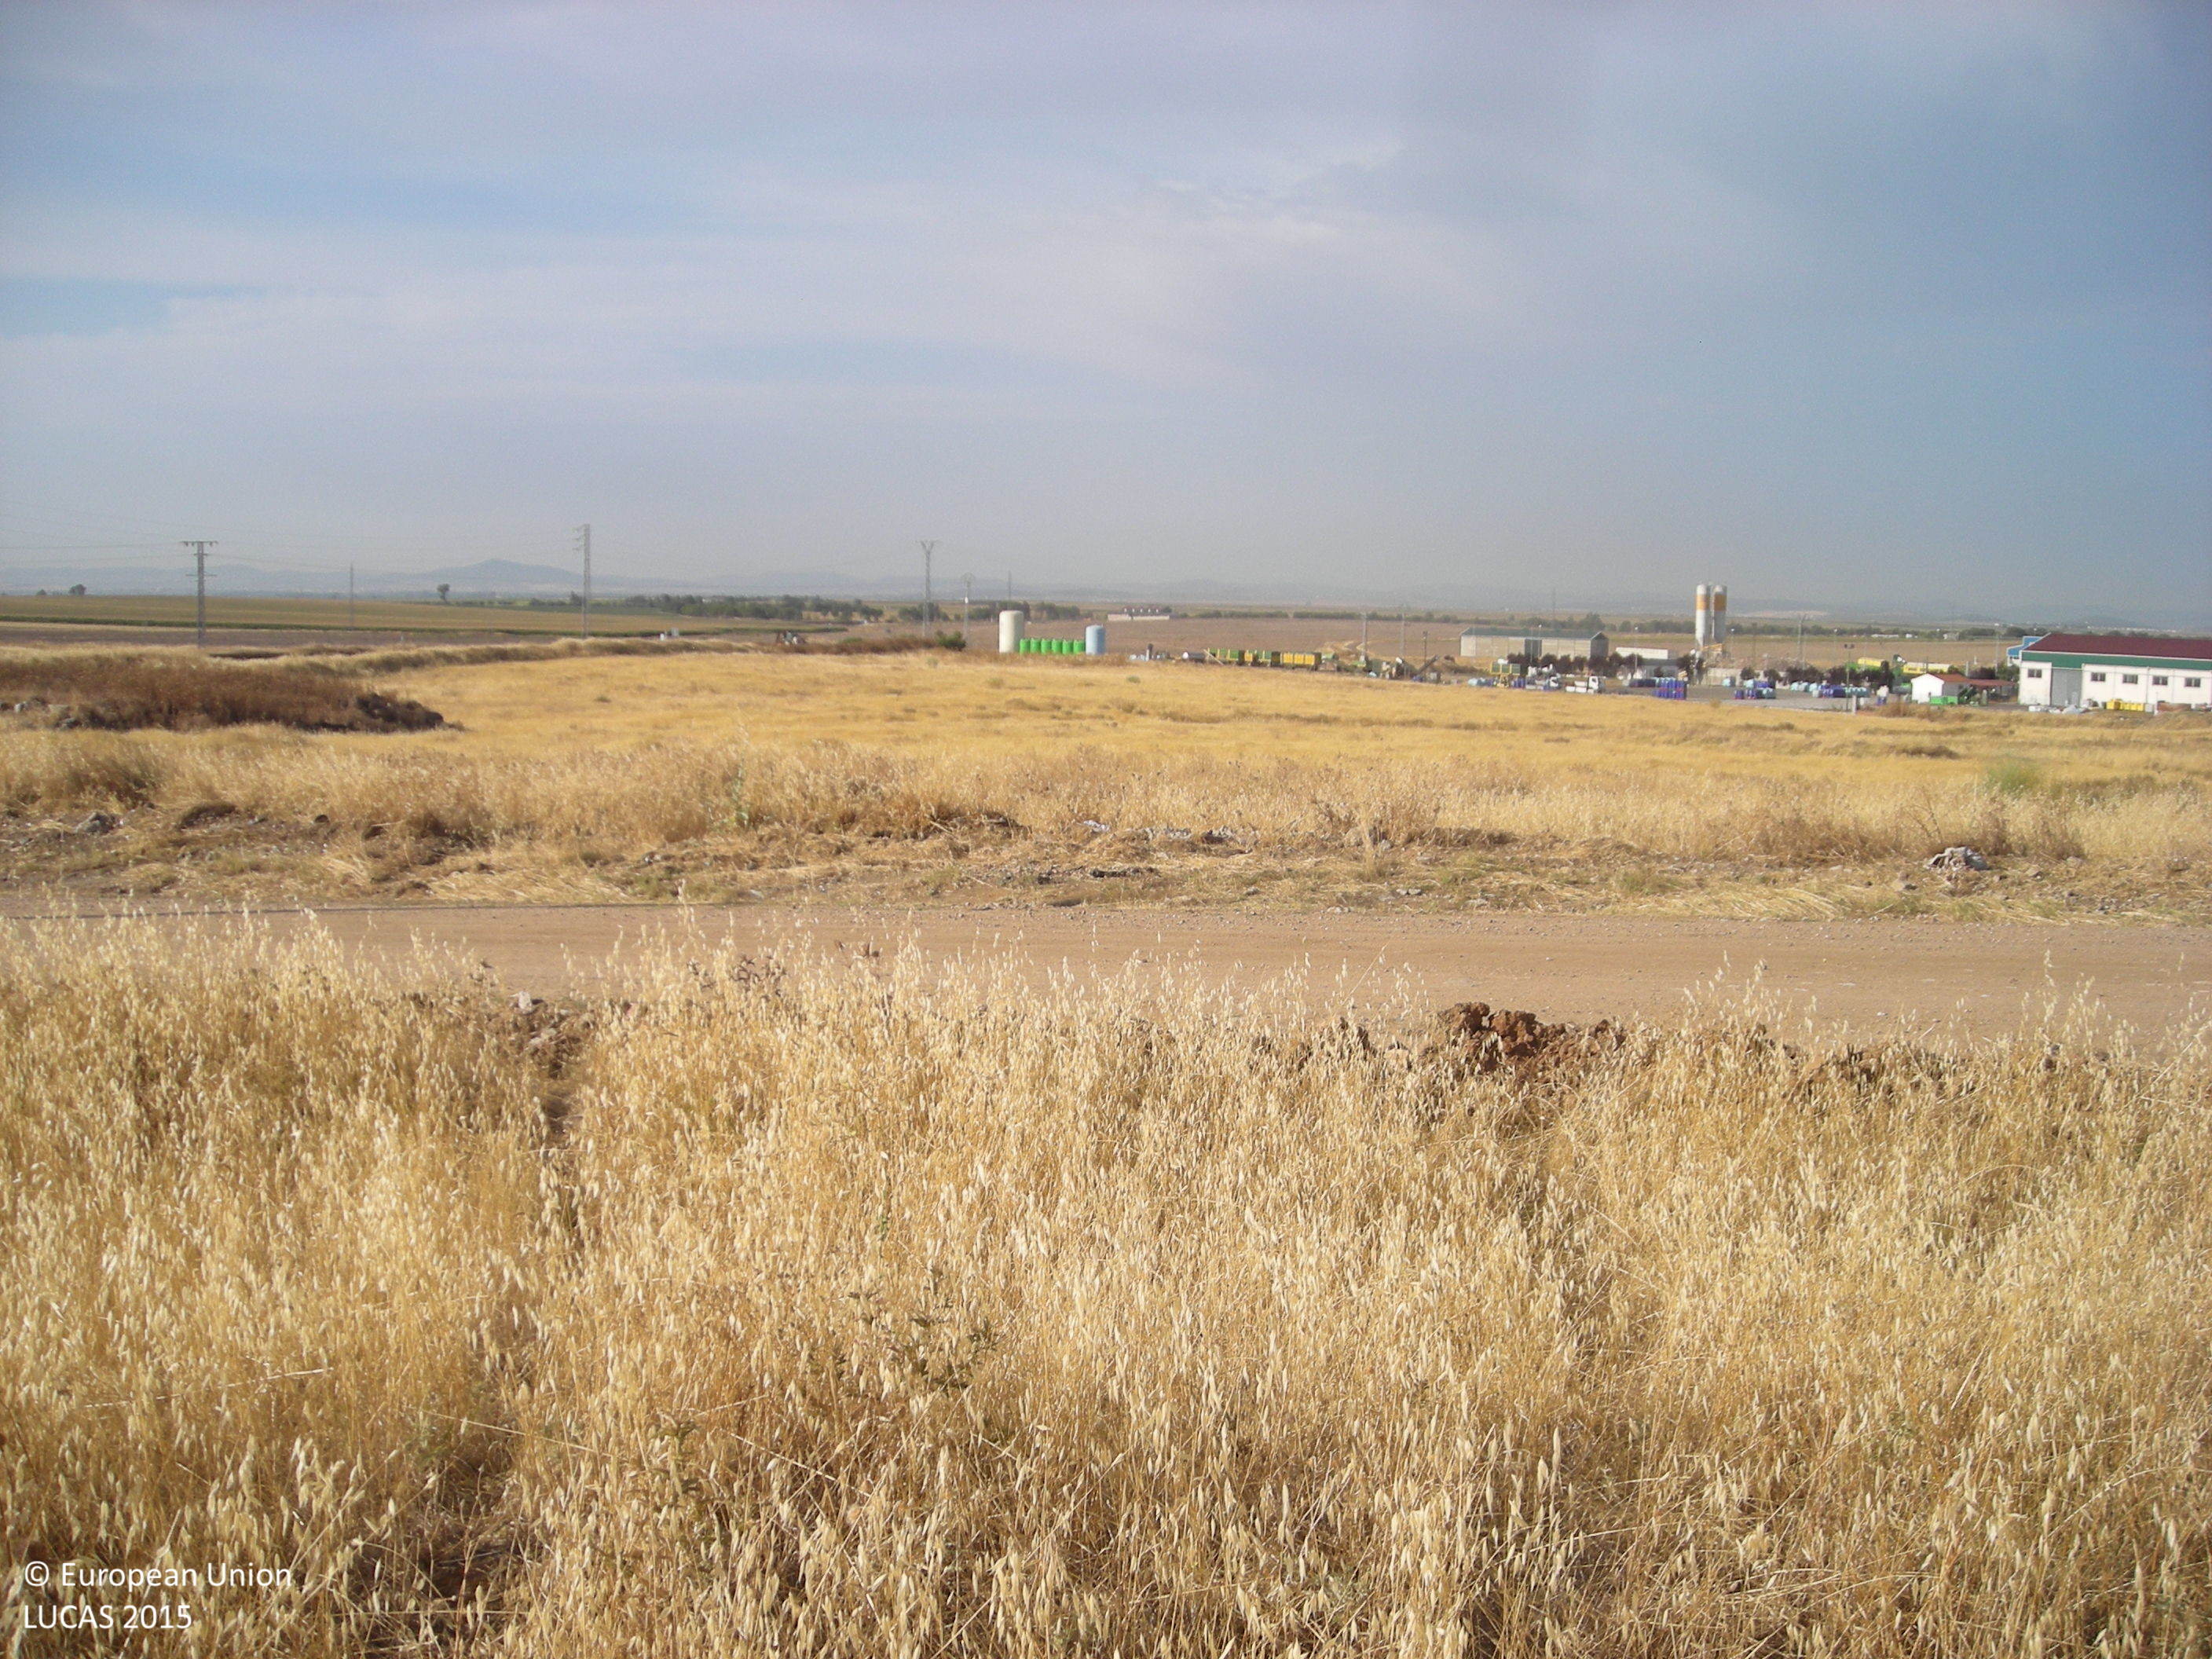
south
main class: Grassland
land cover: Spontaneously vegetated surfaces
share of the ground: 50 - 75 %
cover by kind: herbaceous plants 100 %
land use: Abandoned areas
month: July
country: ES
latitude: 39.1427
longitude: -5.9159
